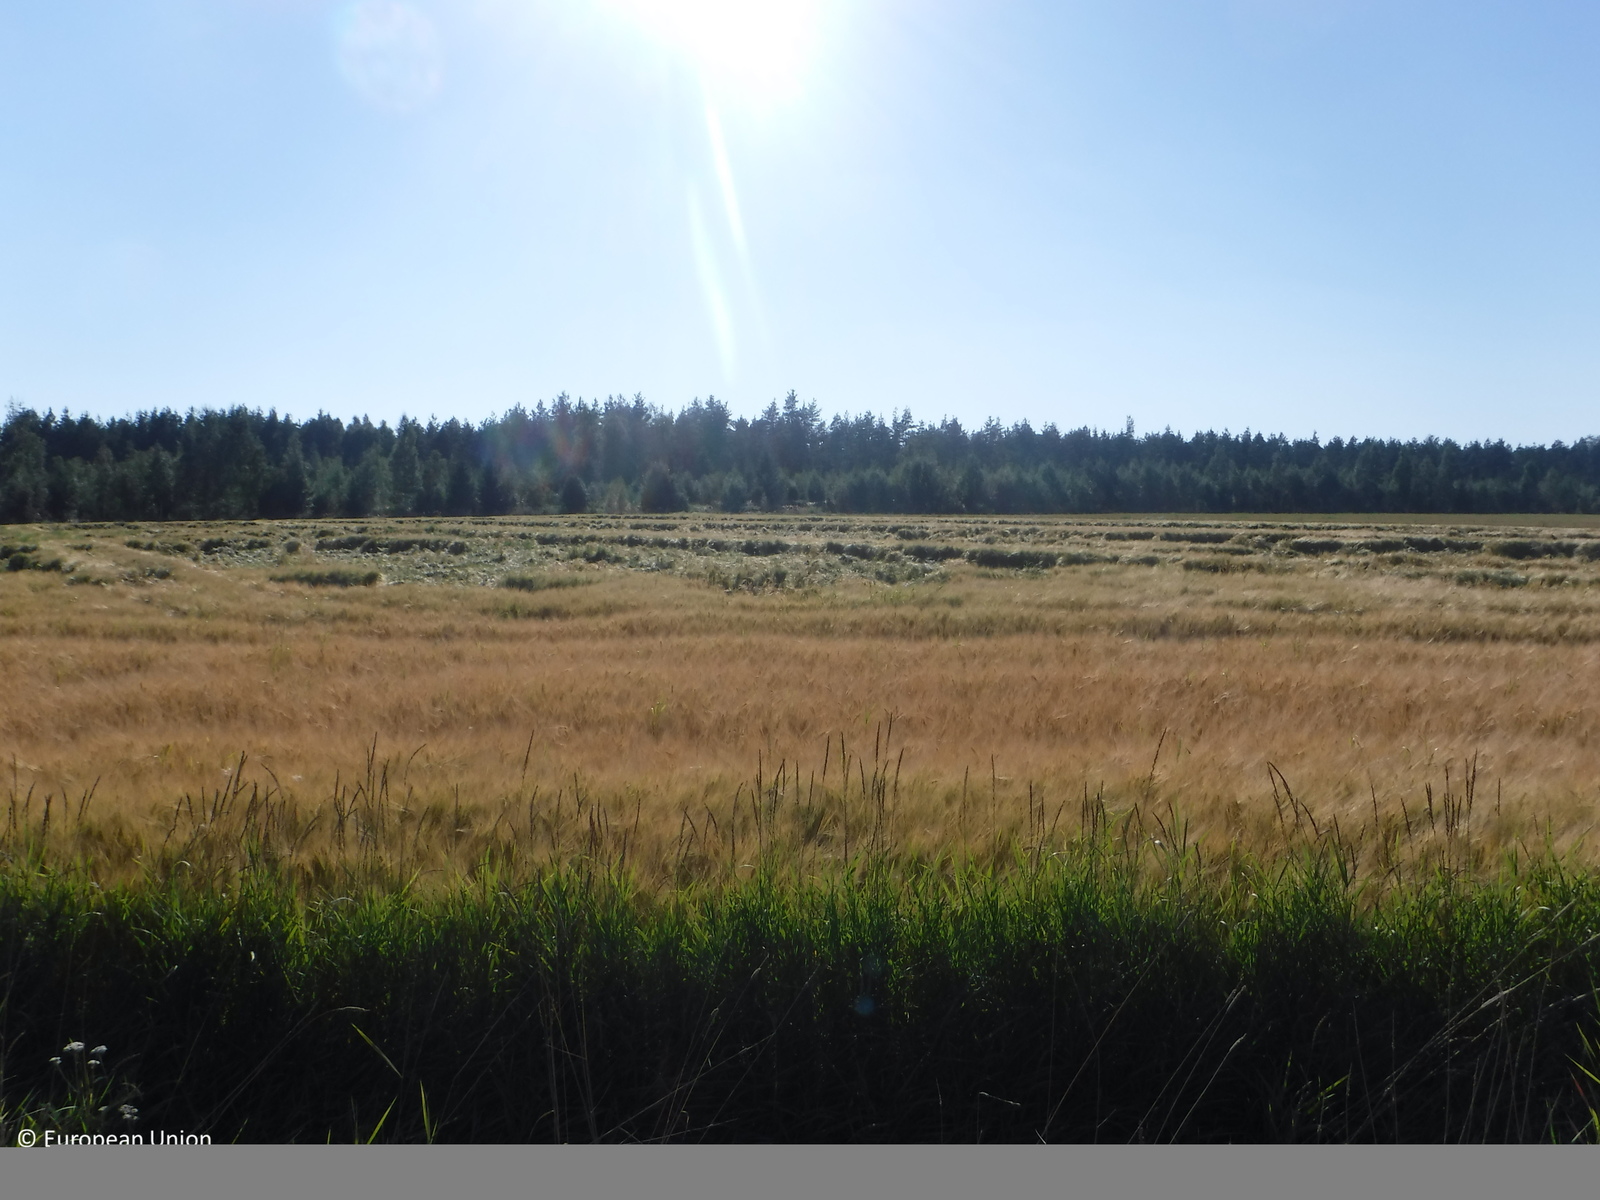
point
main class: Cropland
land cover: Barley
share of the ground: > 75 %
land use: Agriculture (excluding fallow land and kitchen gardens)
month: August
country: FI
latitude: 61.2001
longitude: 22.6278
